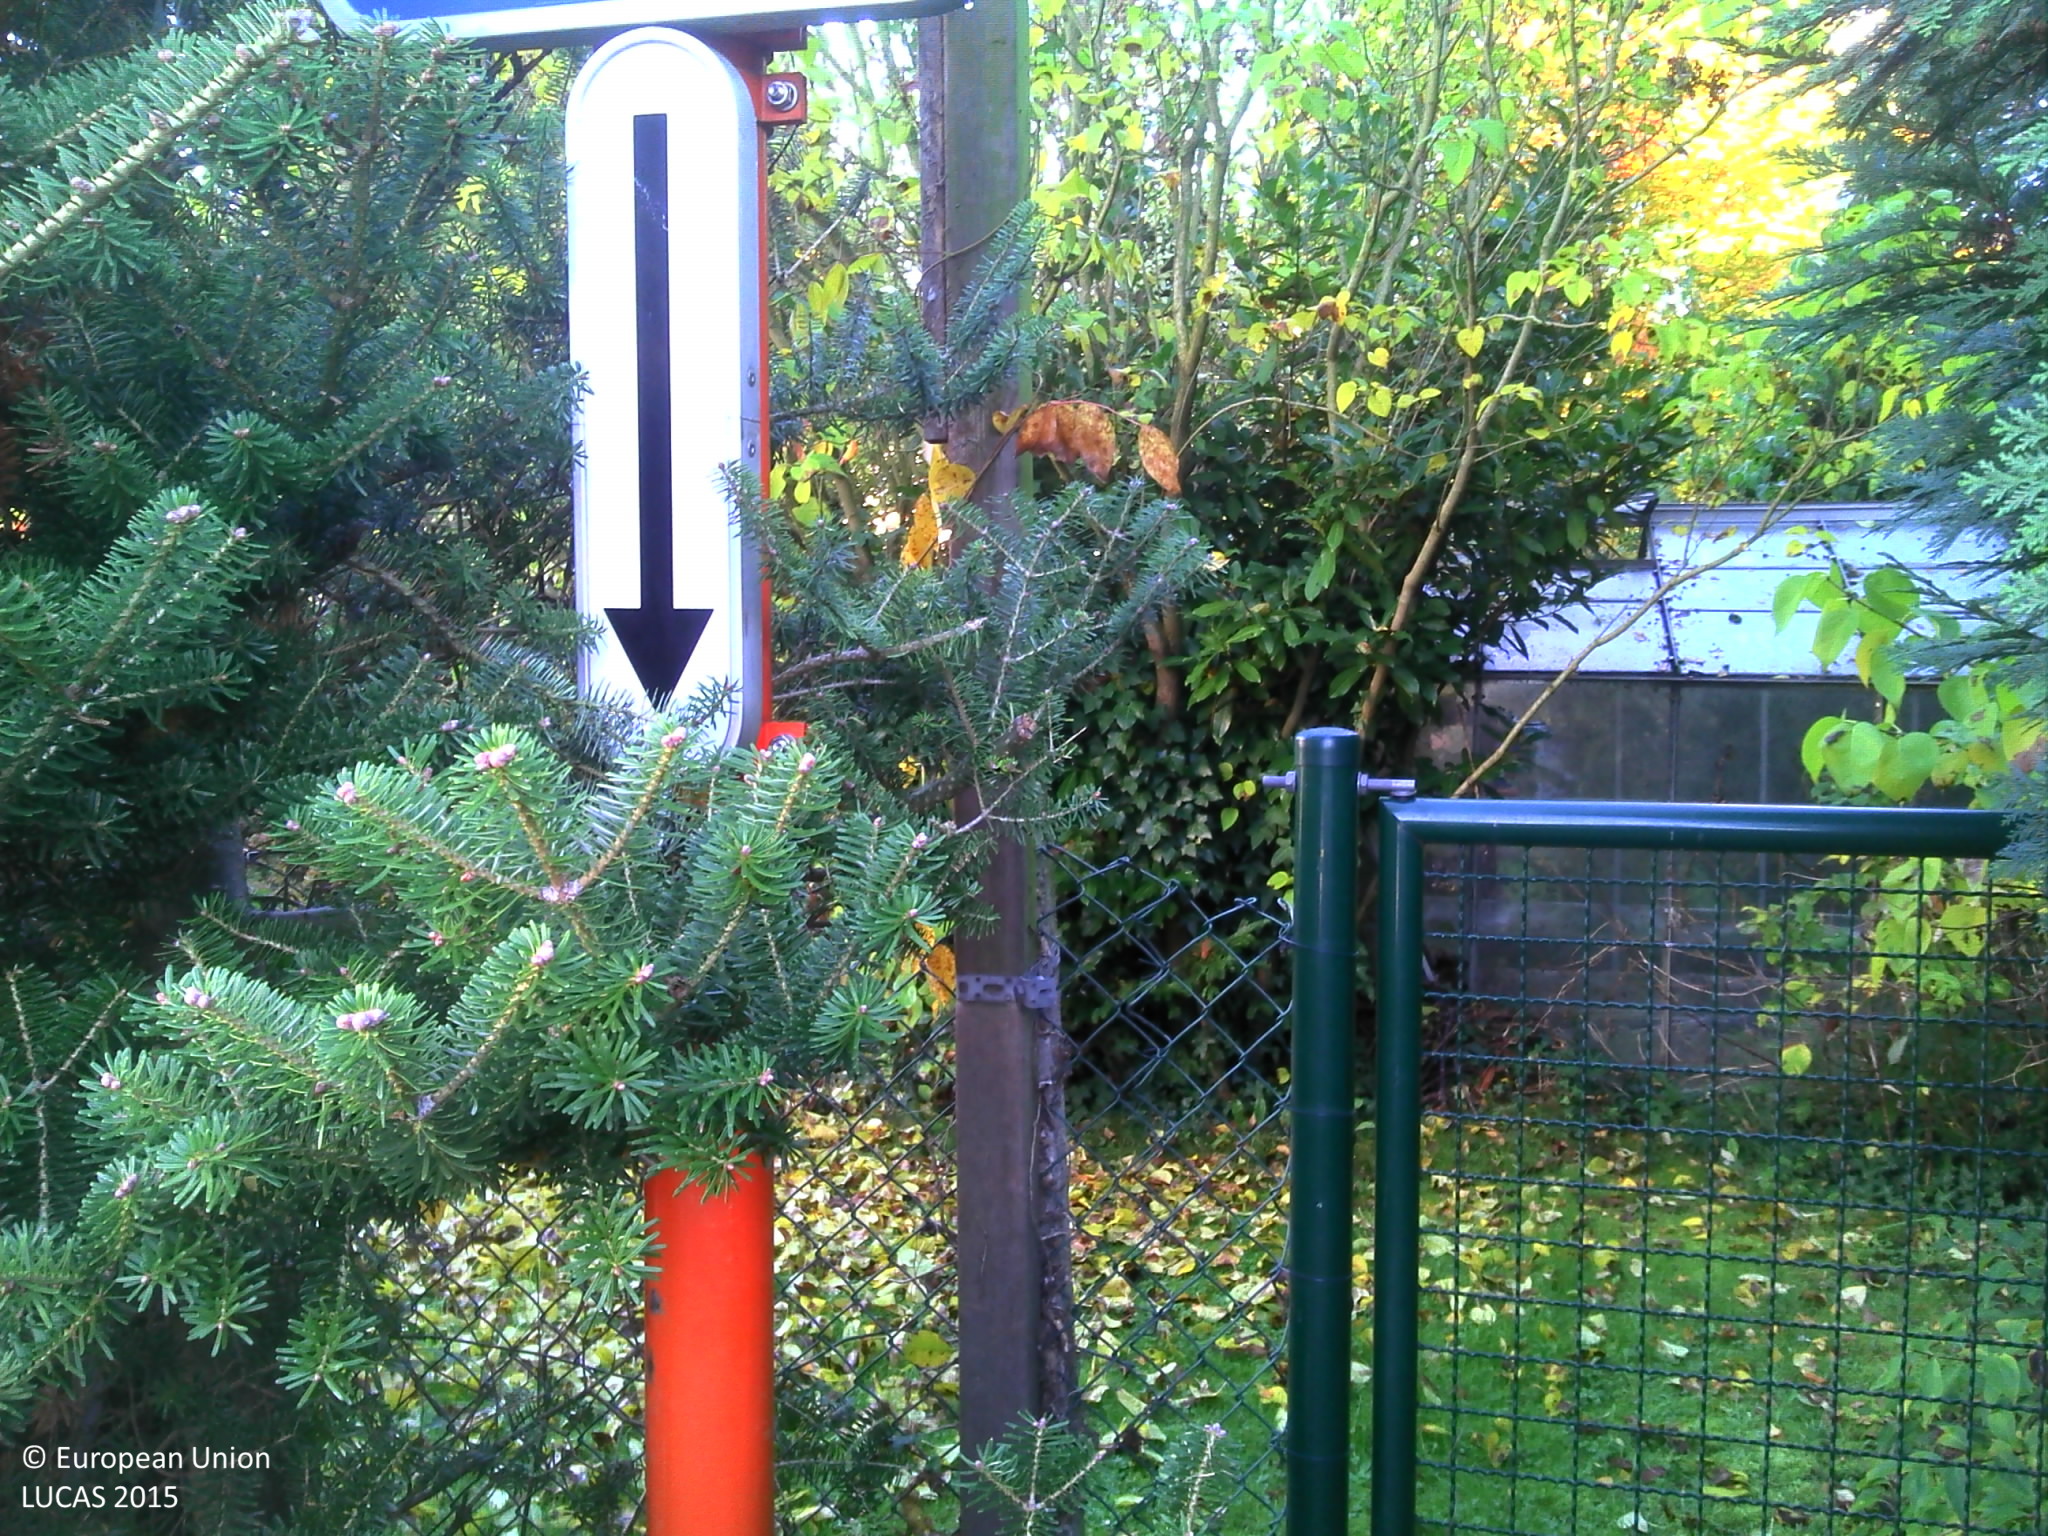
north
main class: Grassland
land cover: Grassland with sparse tree/shrub cover
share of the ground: > 75 %
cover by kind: herbaceous plants 85 %, shrubs 10 %, coniferous forest trees 5 %
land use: Residential
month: October
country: BE
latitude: 50.8432
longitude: 4.4712
